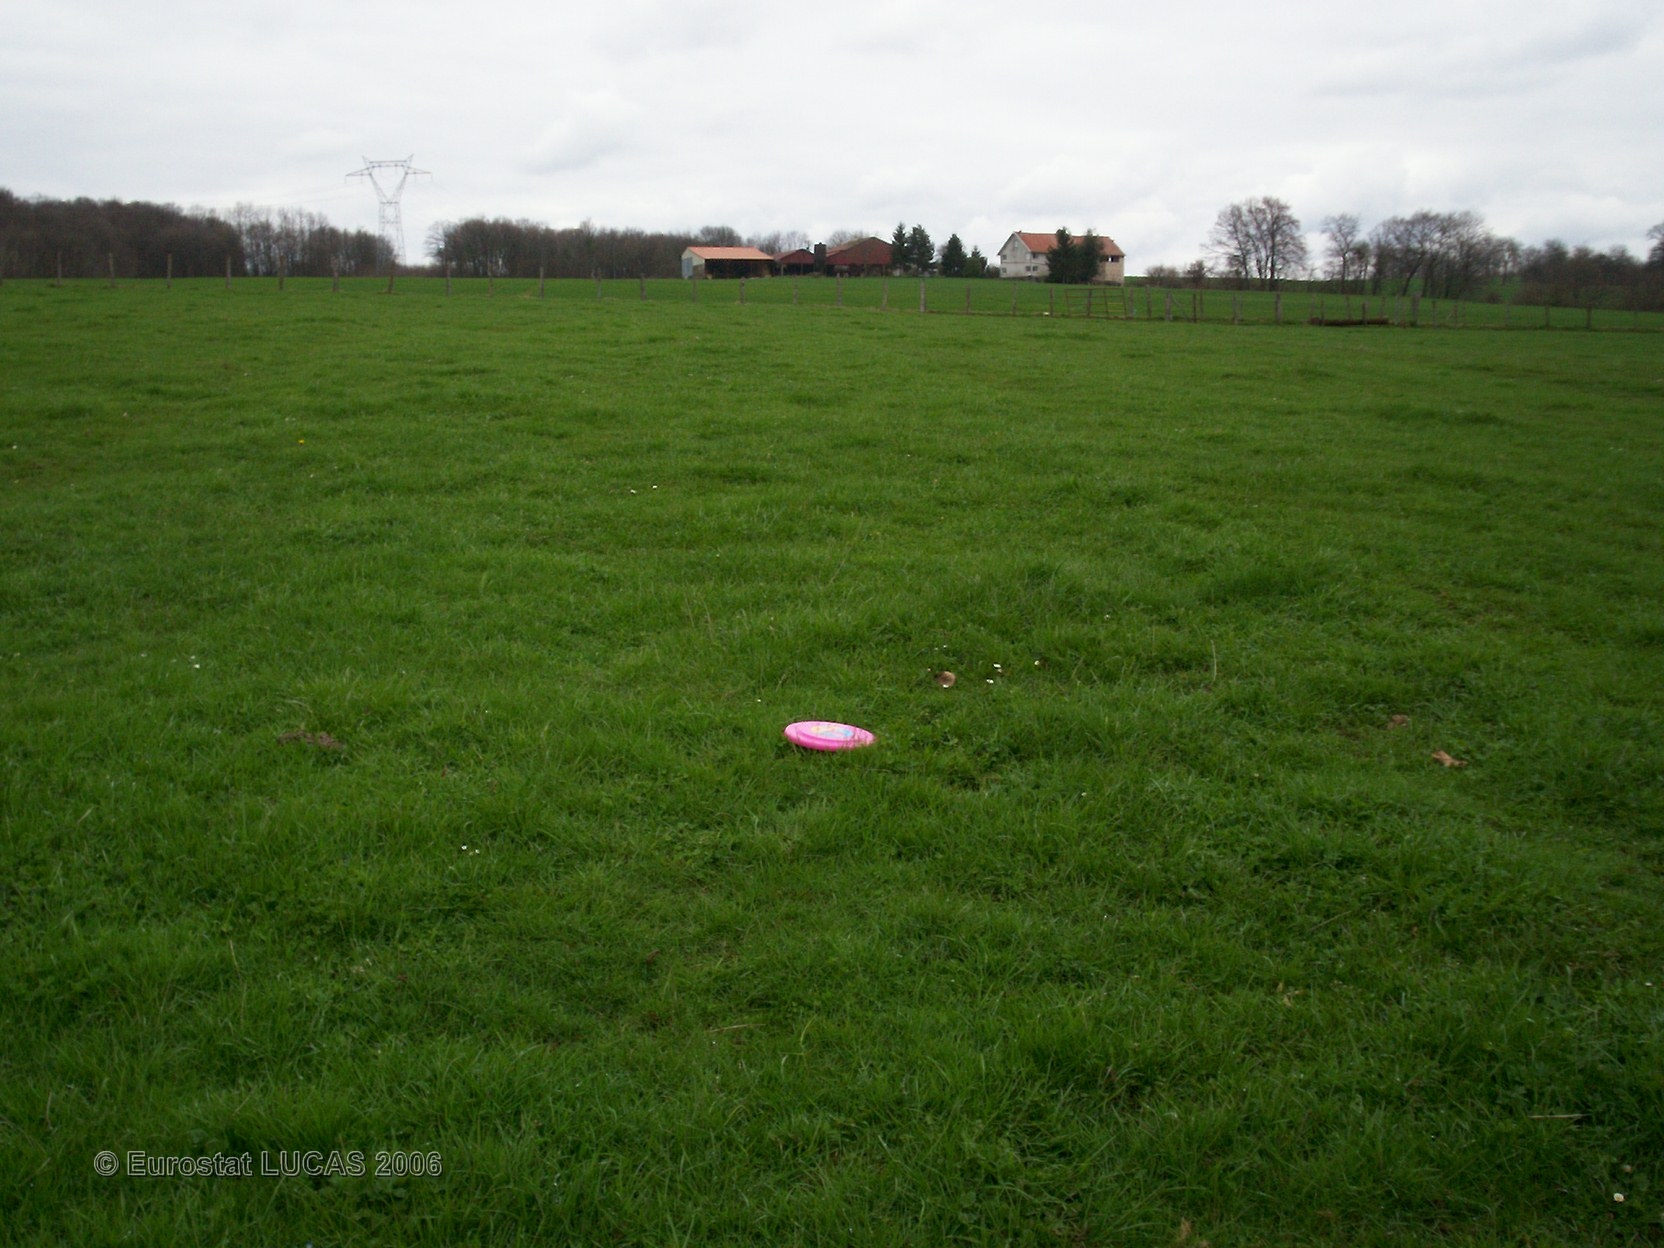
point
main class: Grassland
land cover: Grassland without tree/shrub cover
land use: Agriculture (excluding fallow land and kitchen gardens)
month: April
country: FR
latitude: 47.5647
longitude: 6.7984
